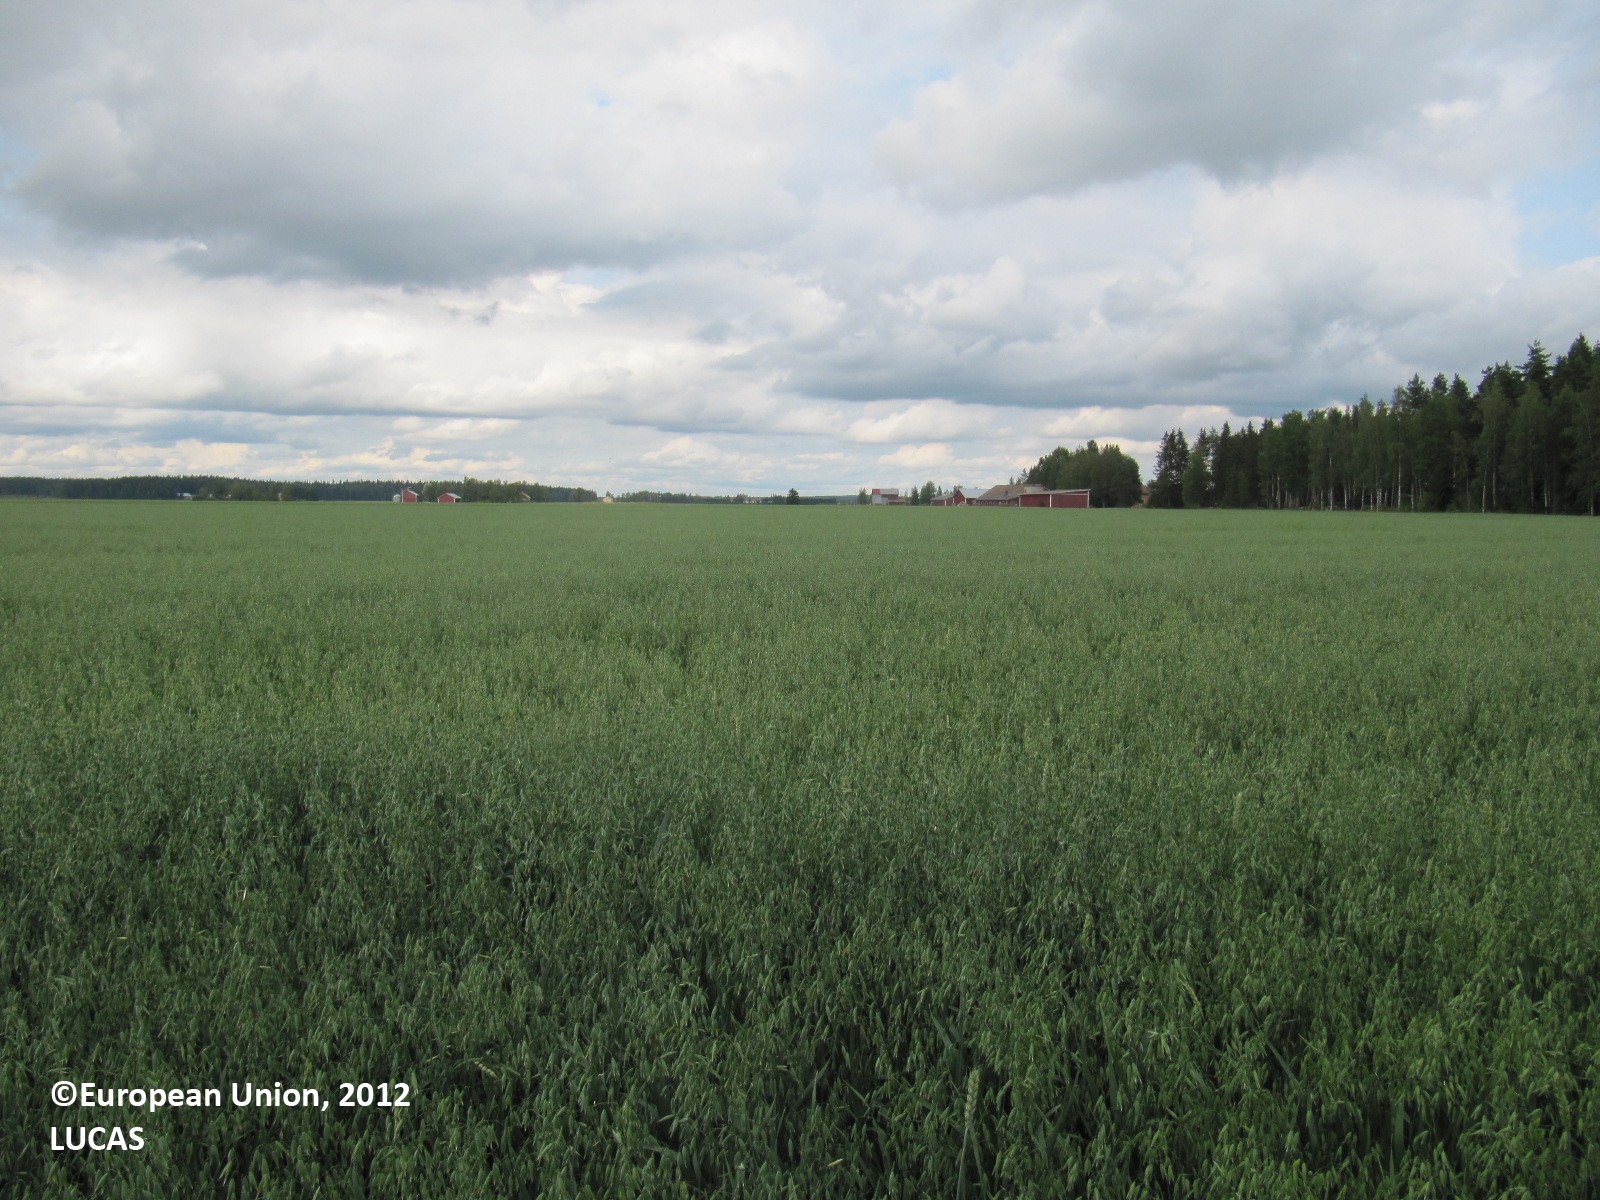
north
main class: Cropland
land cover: Oats
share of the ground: > 75 %
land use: Agriculture (excluding fallow land and kitchen gardens)
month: July
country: FI
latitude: 60.6271
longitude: 23.2965
